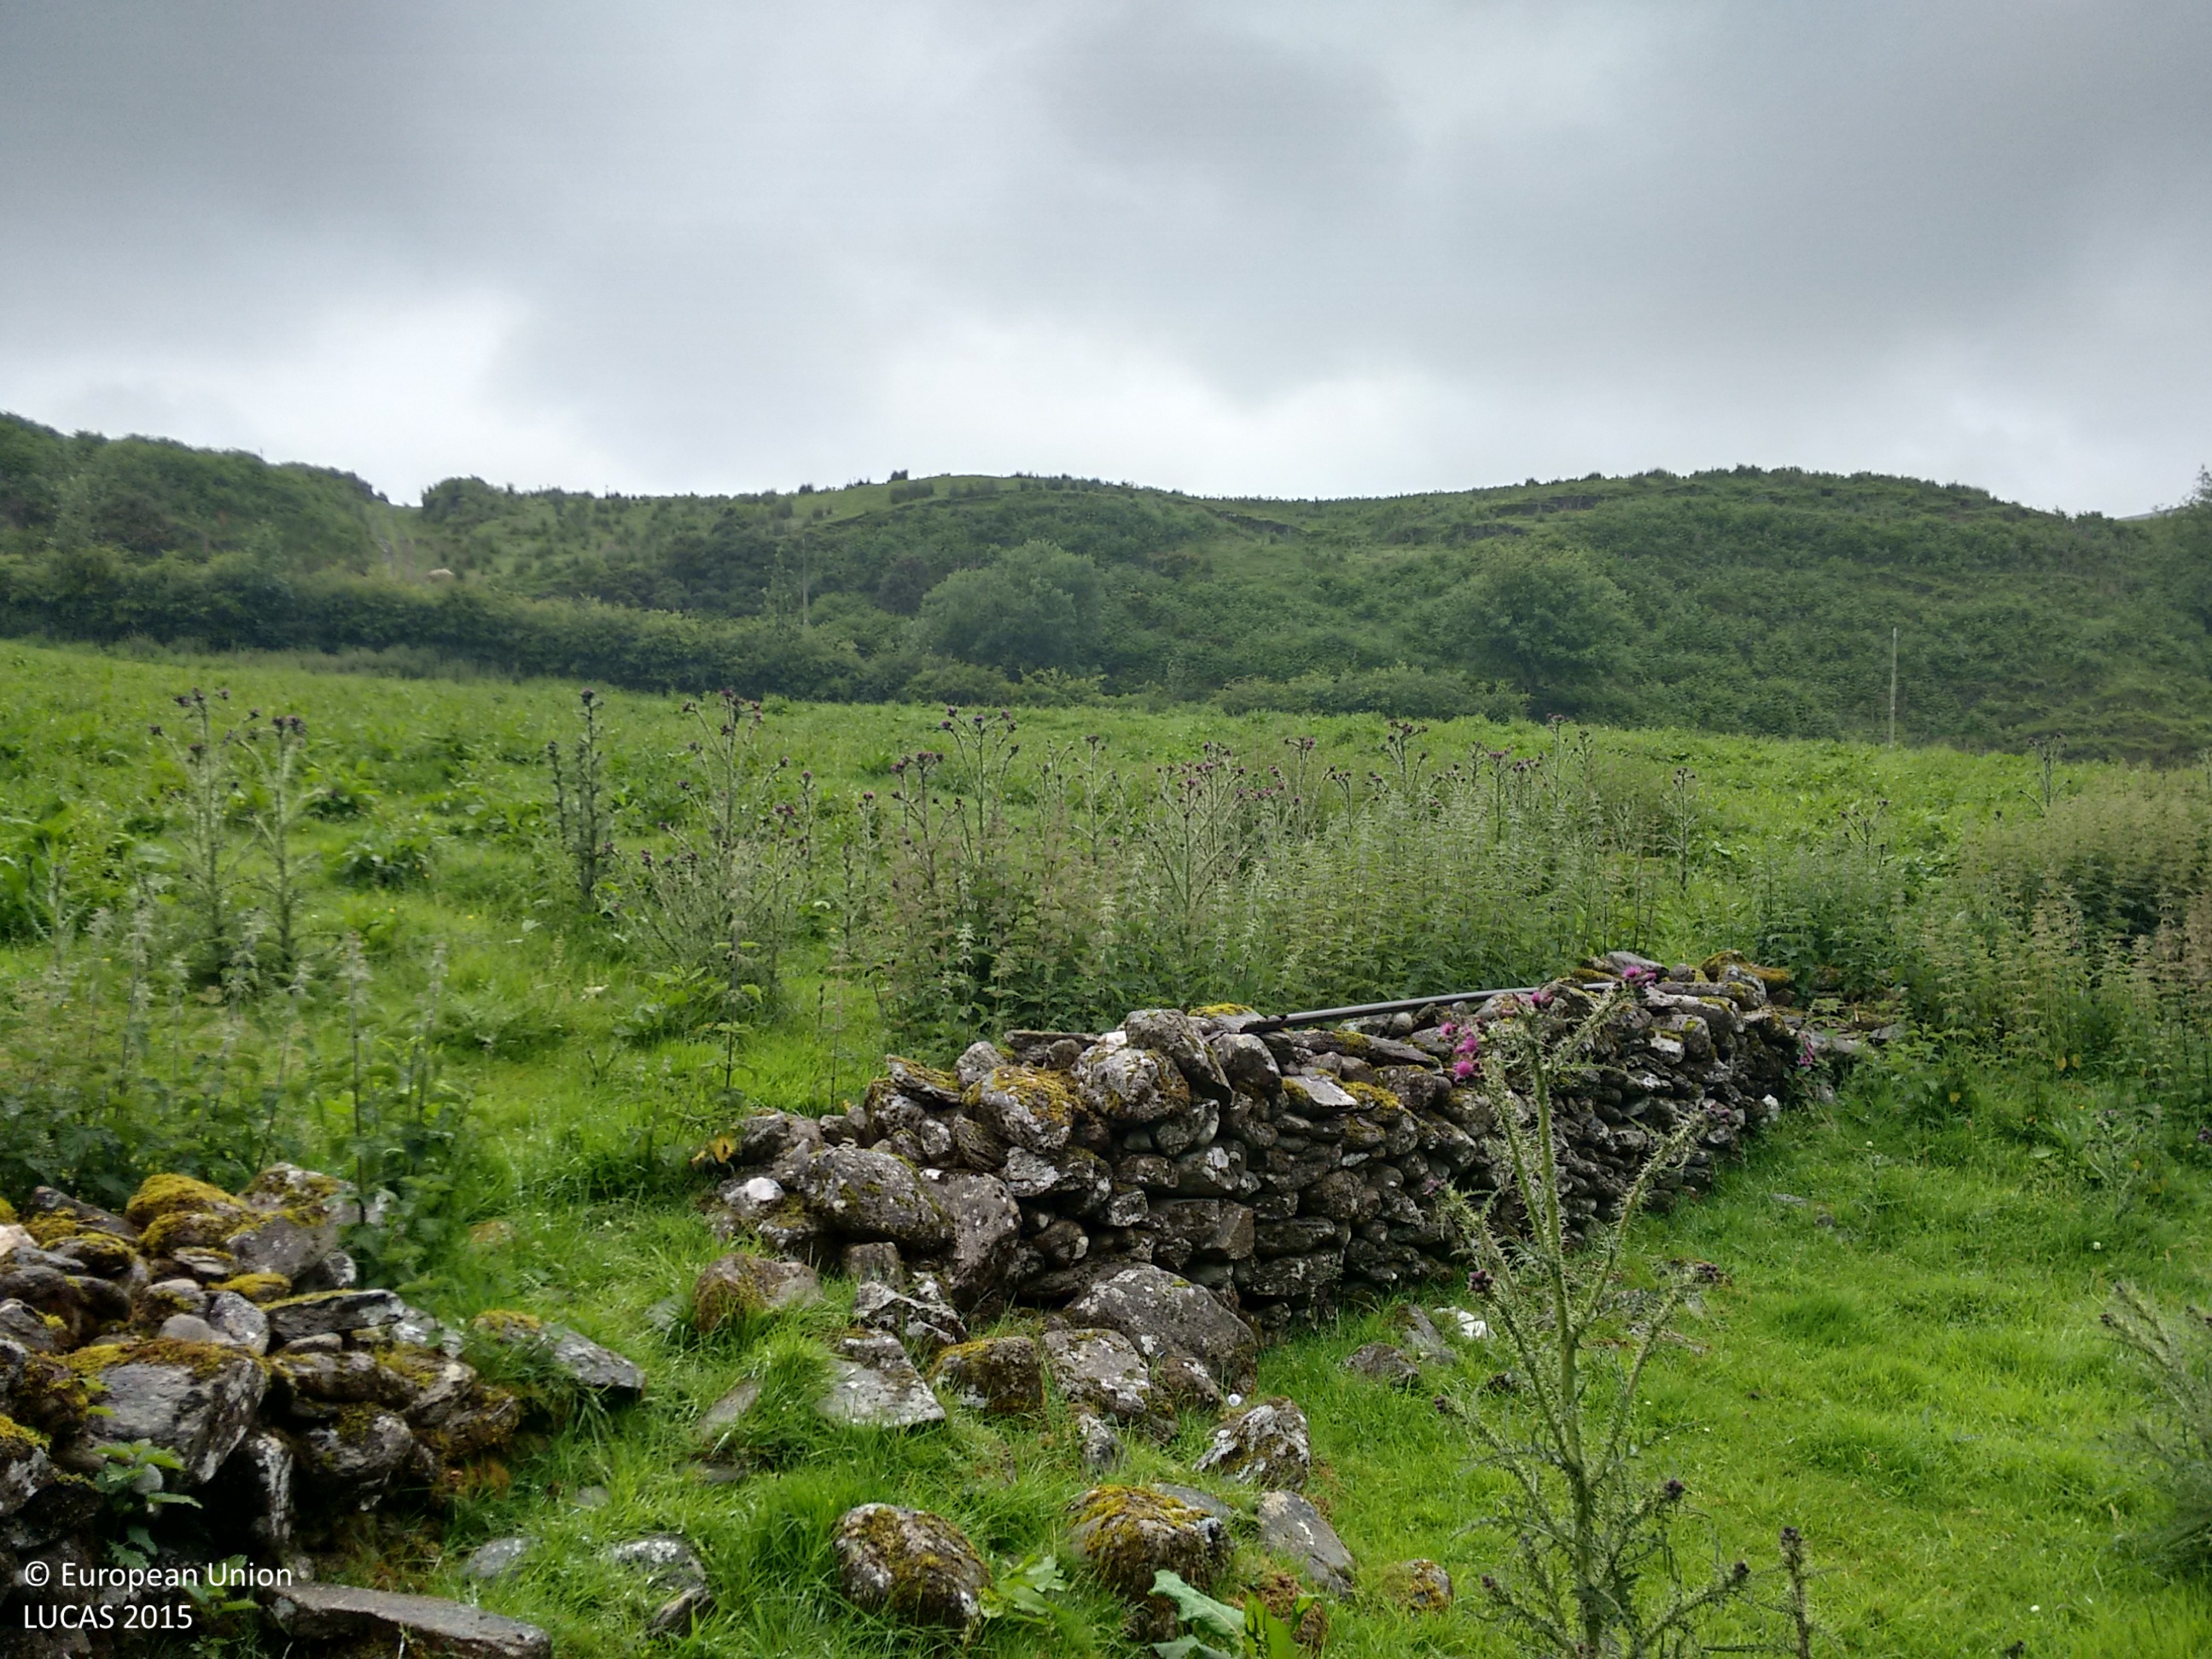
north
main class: Grassland
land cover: Grassland without tree/shrub cover
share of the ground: > 75 %
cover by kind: herbaceous plants 100 %
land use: Agriculture (excluding fallow land and kitchen gardens)
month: July
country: GB
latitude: 54.7897
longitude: -6.9483
